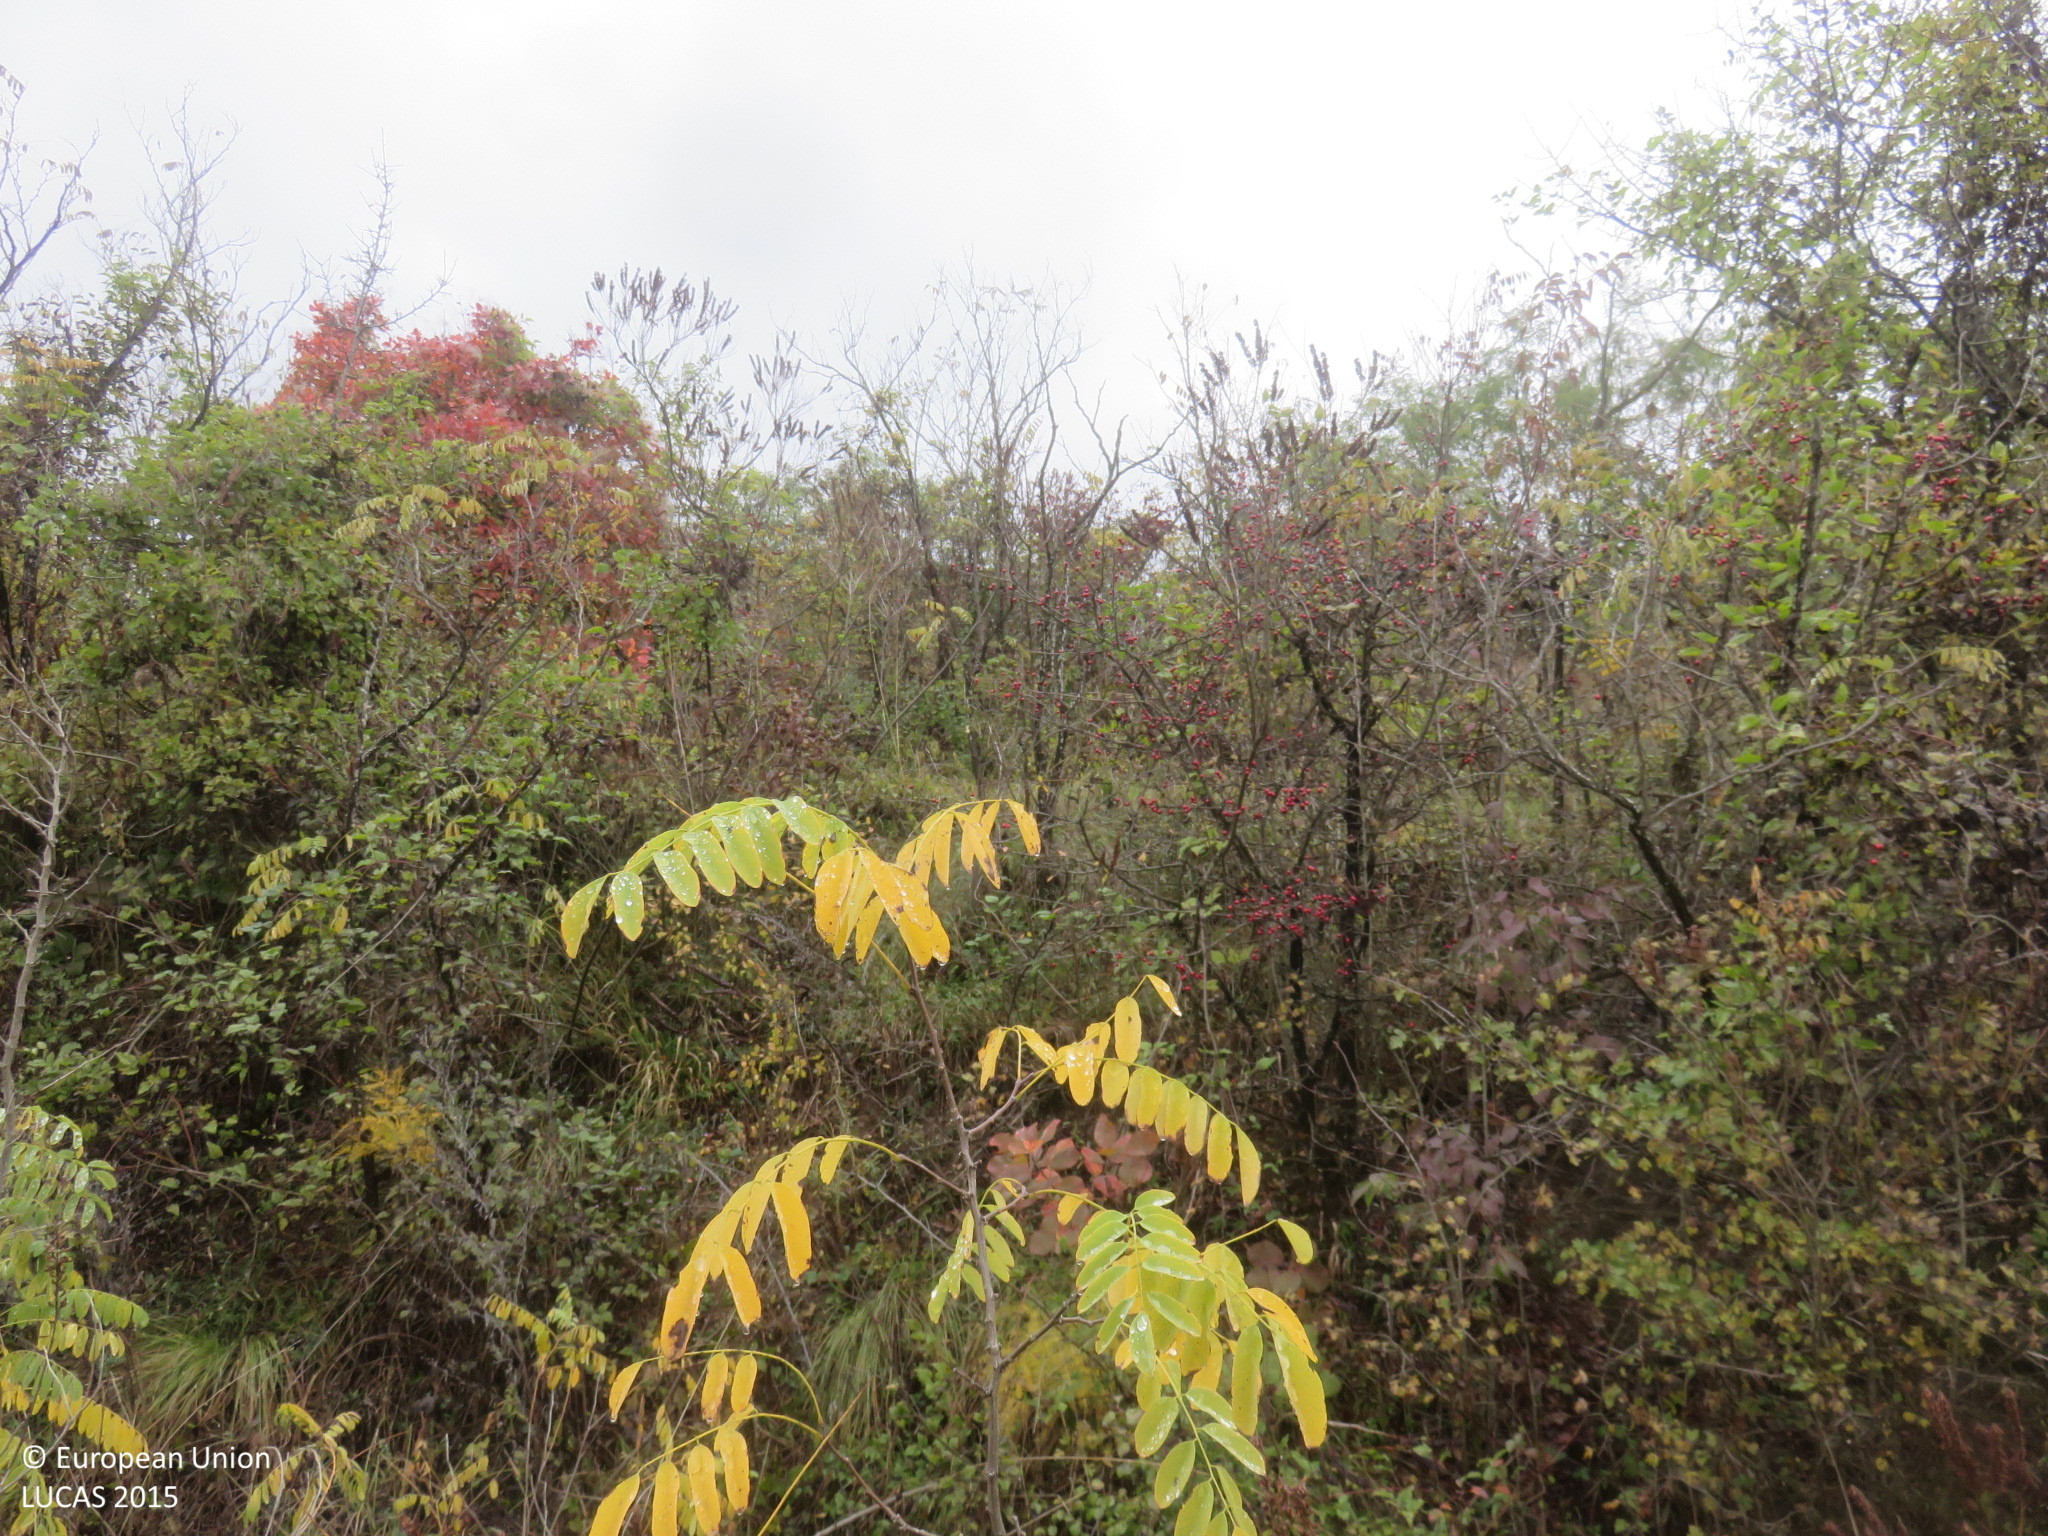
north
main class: Woodland
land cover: Broadleaved woodland
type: mesophytic deciduous forest
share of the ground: > 75 %
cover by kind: broadleaved forest trees 95 %, shrubs 5 %
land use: Semi-natural and natural areas not in use
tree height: > 5 m
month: October
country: BG
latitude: 43.0819
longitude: 25.0406
